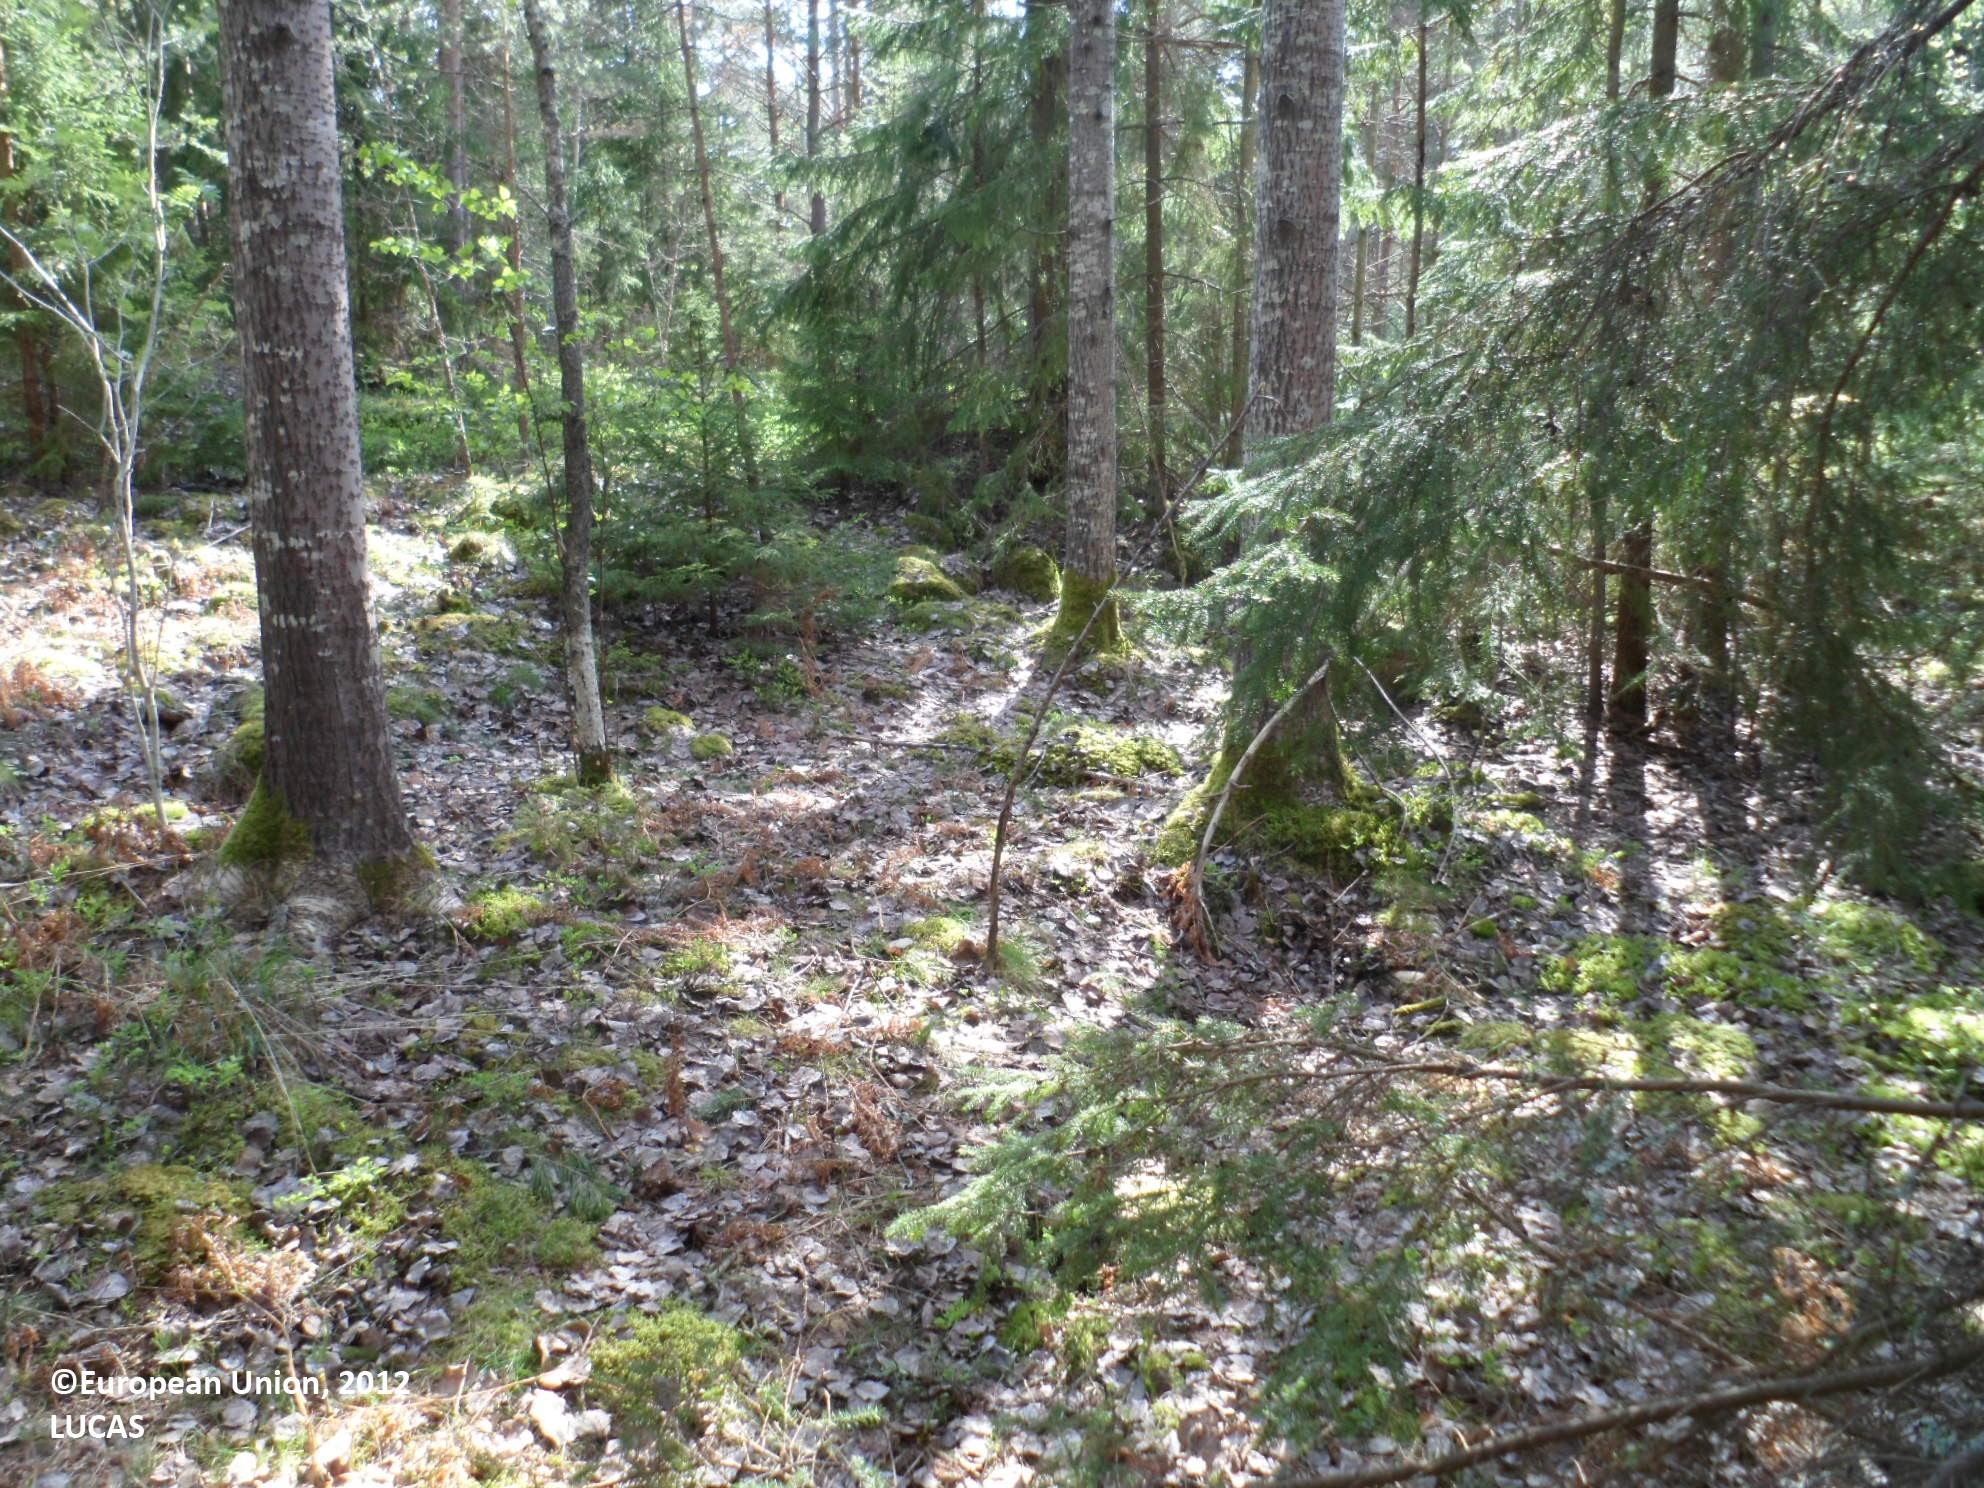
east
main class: Woodland
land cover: Spruce dominated coniferous woodland
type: boreal forest
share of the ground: > 75 %
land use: Forestry
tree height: > 5 m
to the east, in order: Spruce dominated coniferous woodland; Pine dominated coniferous woodland; Spruce dominated mixed woodland; Tracks; Pine dominated coniferous woodland; Spruce dominated mixed woodland; Pine dominated coniferous woodland; Spruce dominated mixed woodland
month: May
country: SE
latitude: 59.4852
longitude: 18.5640
